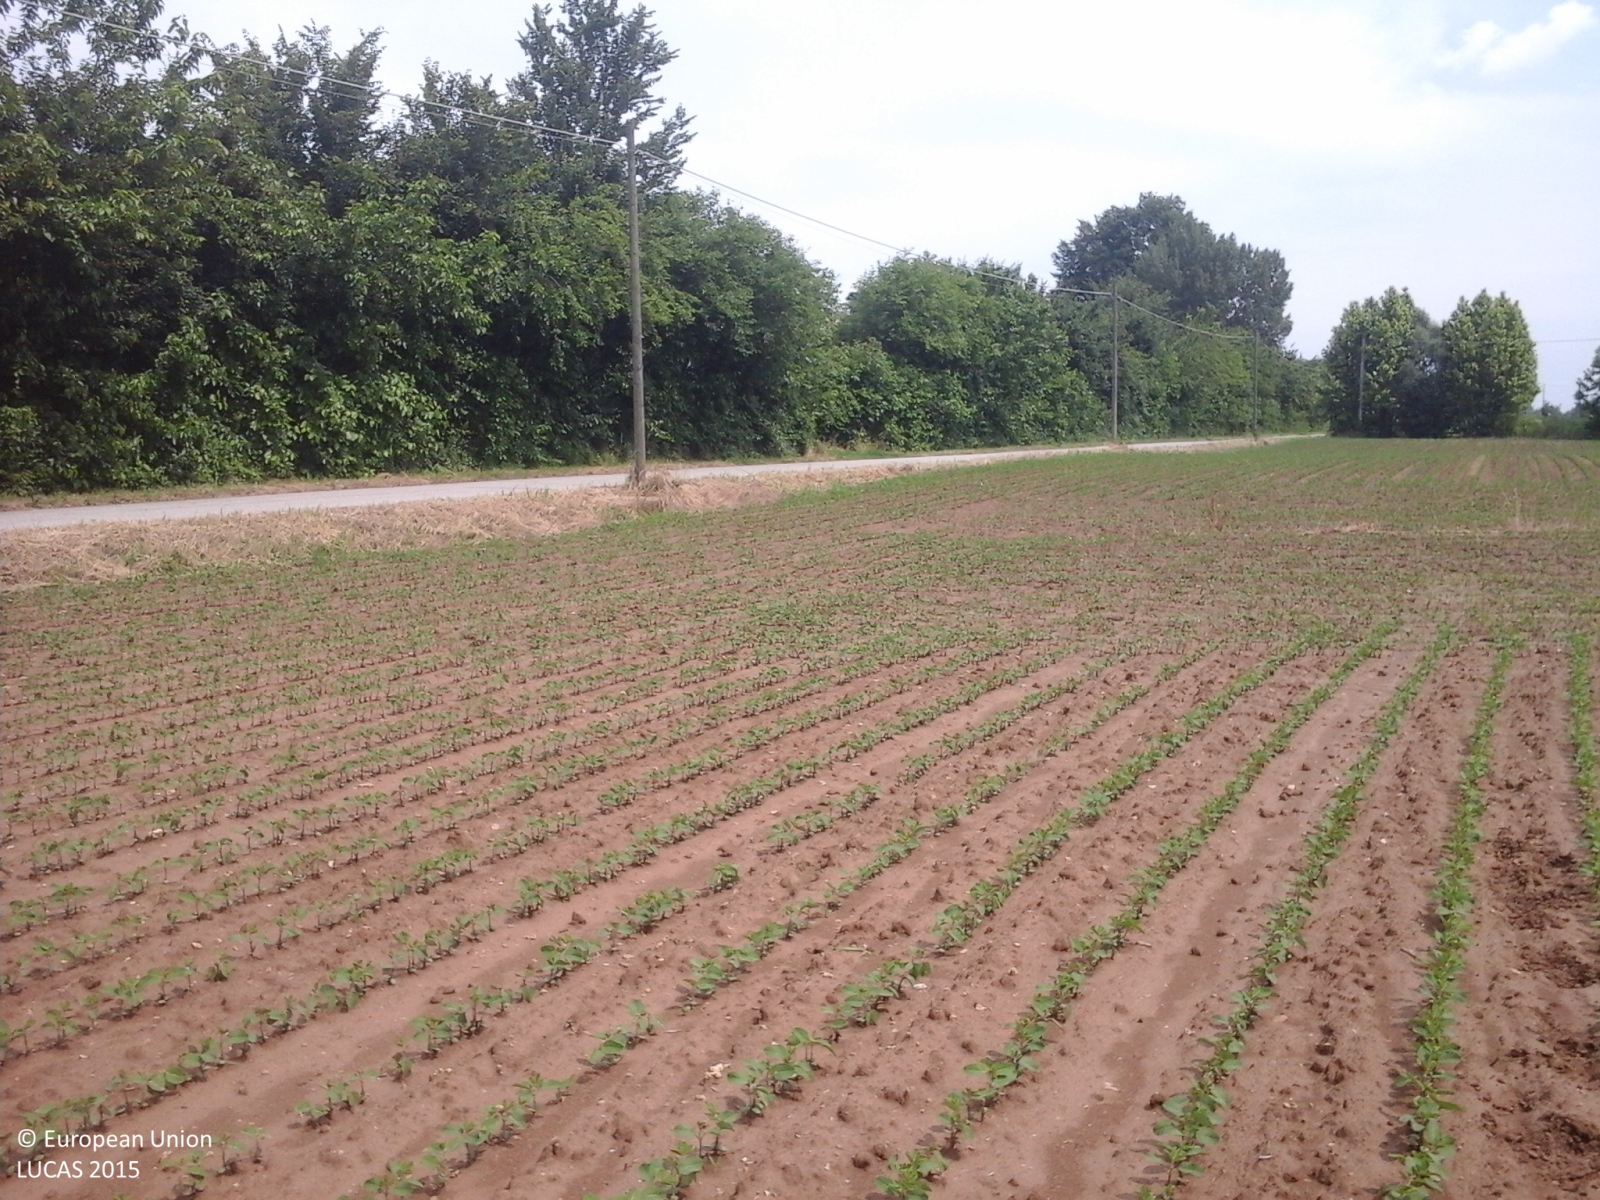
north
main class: Cropland
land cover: Soya
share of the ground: < 10 %
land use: Agriculture (excluding fallow land and kitchen gardens)
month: May
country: IT
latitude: 45.4203
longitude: 11.5948
